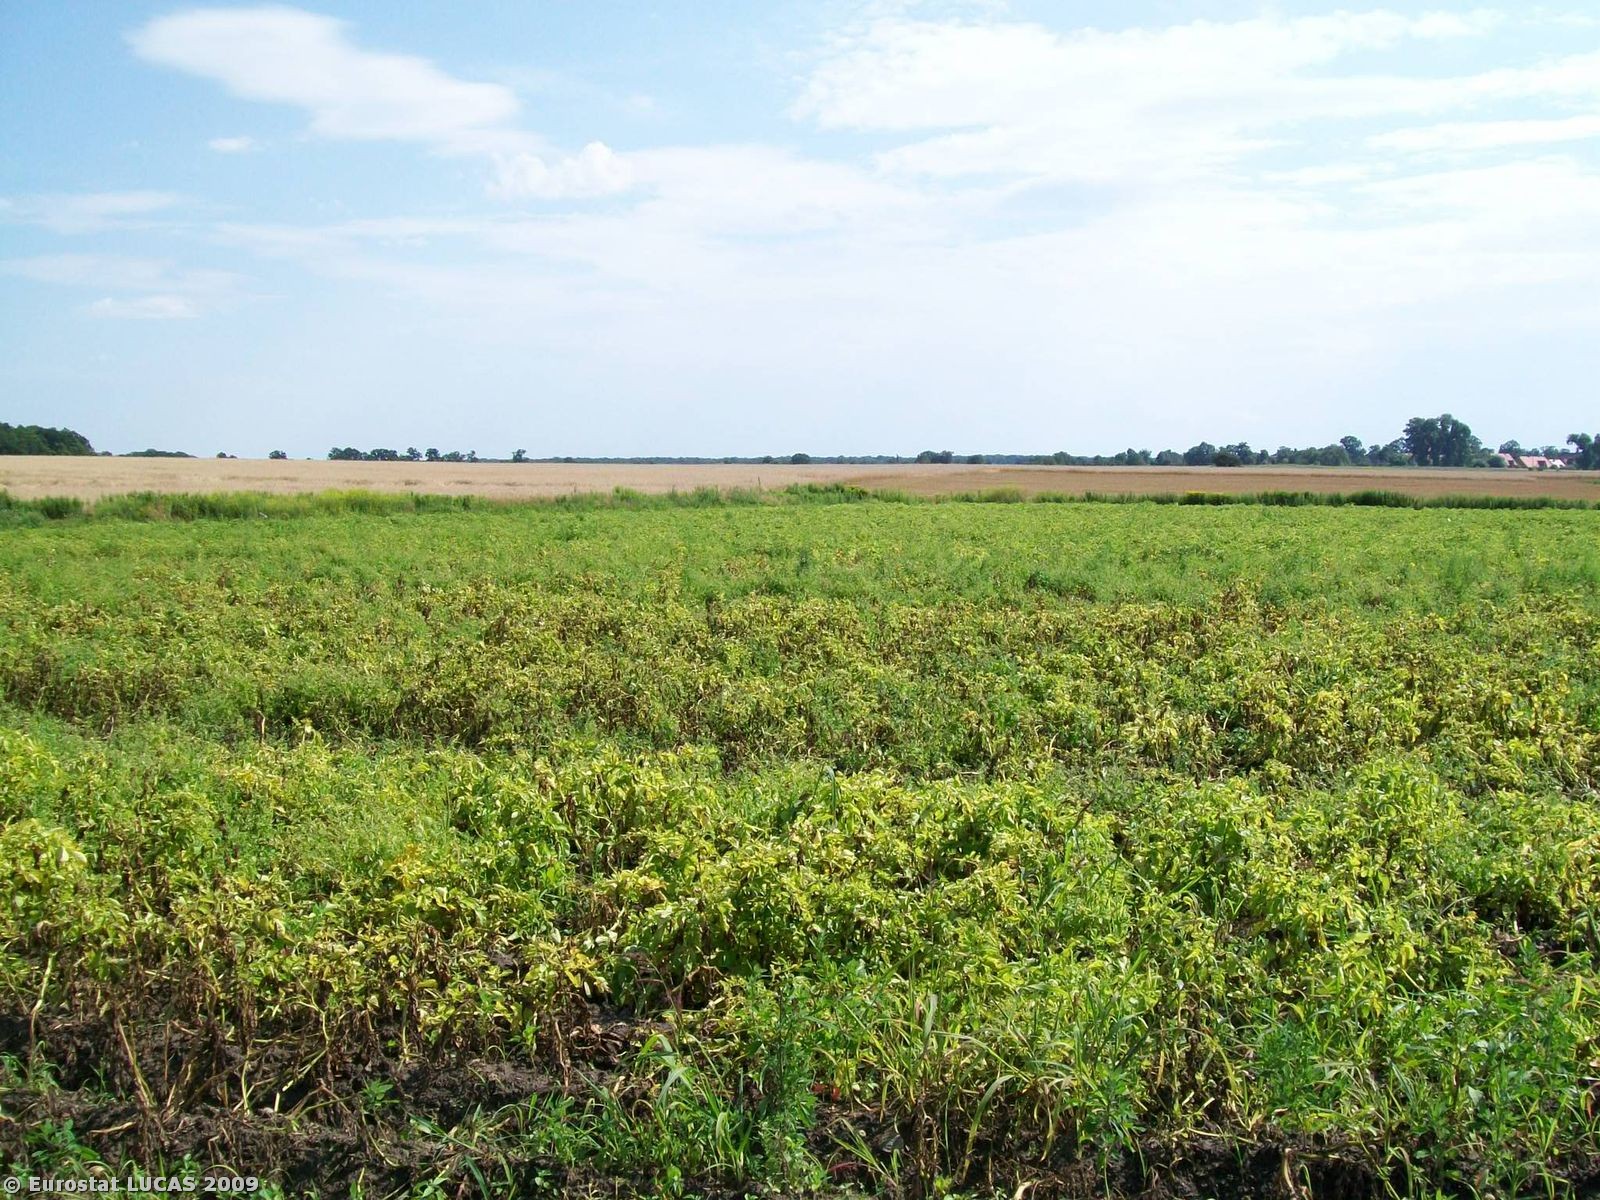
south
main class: Grassland
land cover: Spontaneously vegetated surfaces
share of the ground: > 75 %
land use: Fallow land
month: July
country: PL
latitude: 51.1425
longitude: 17.2871
